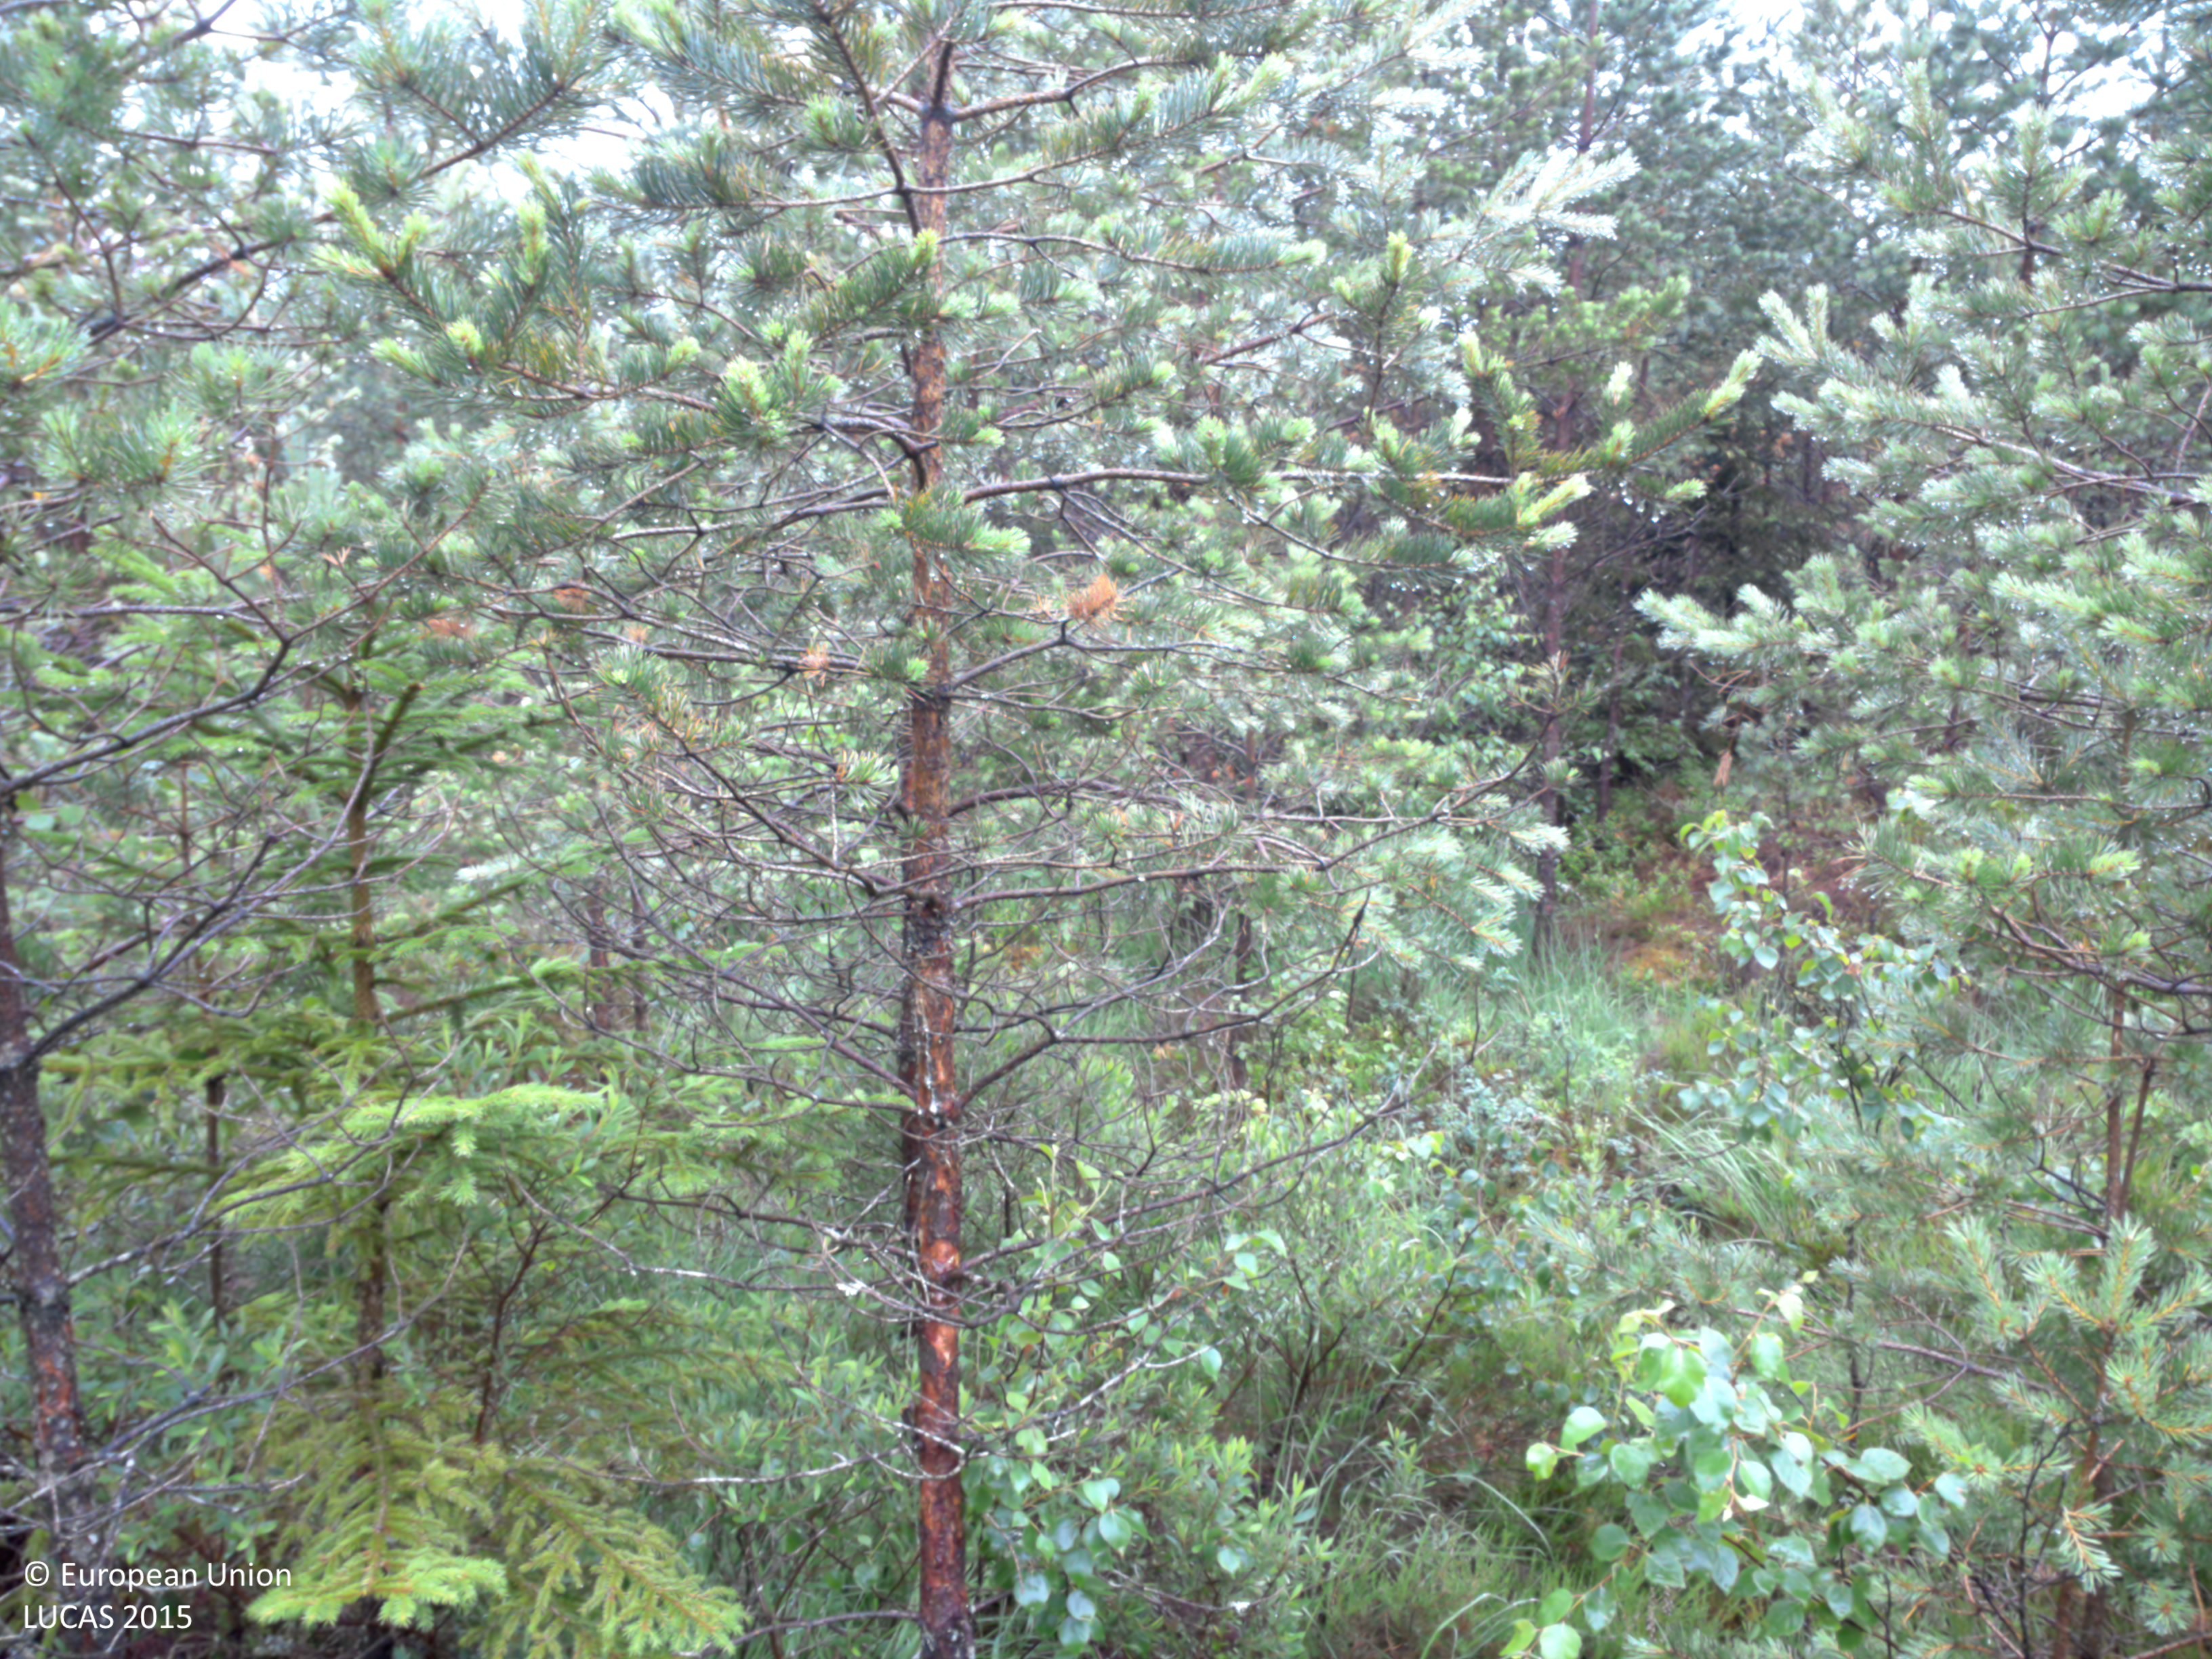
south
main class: Woodland
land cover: Pine dominated mixed woodland
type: boreal forest
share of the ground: 50 - 75 %
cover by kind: coniferous forest trees 40 %, herbaceous plants 30 %, broadleaved forest trees 15 %, shrubs 15 %
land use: Forestry
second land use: Amenities, museums, leisure
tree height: < 5 m
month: July
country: SE
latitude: 58.6944
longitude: 11.7044
